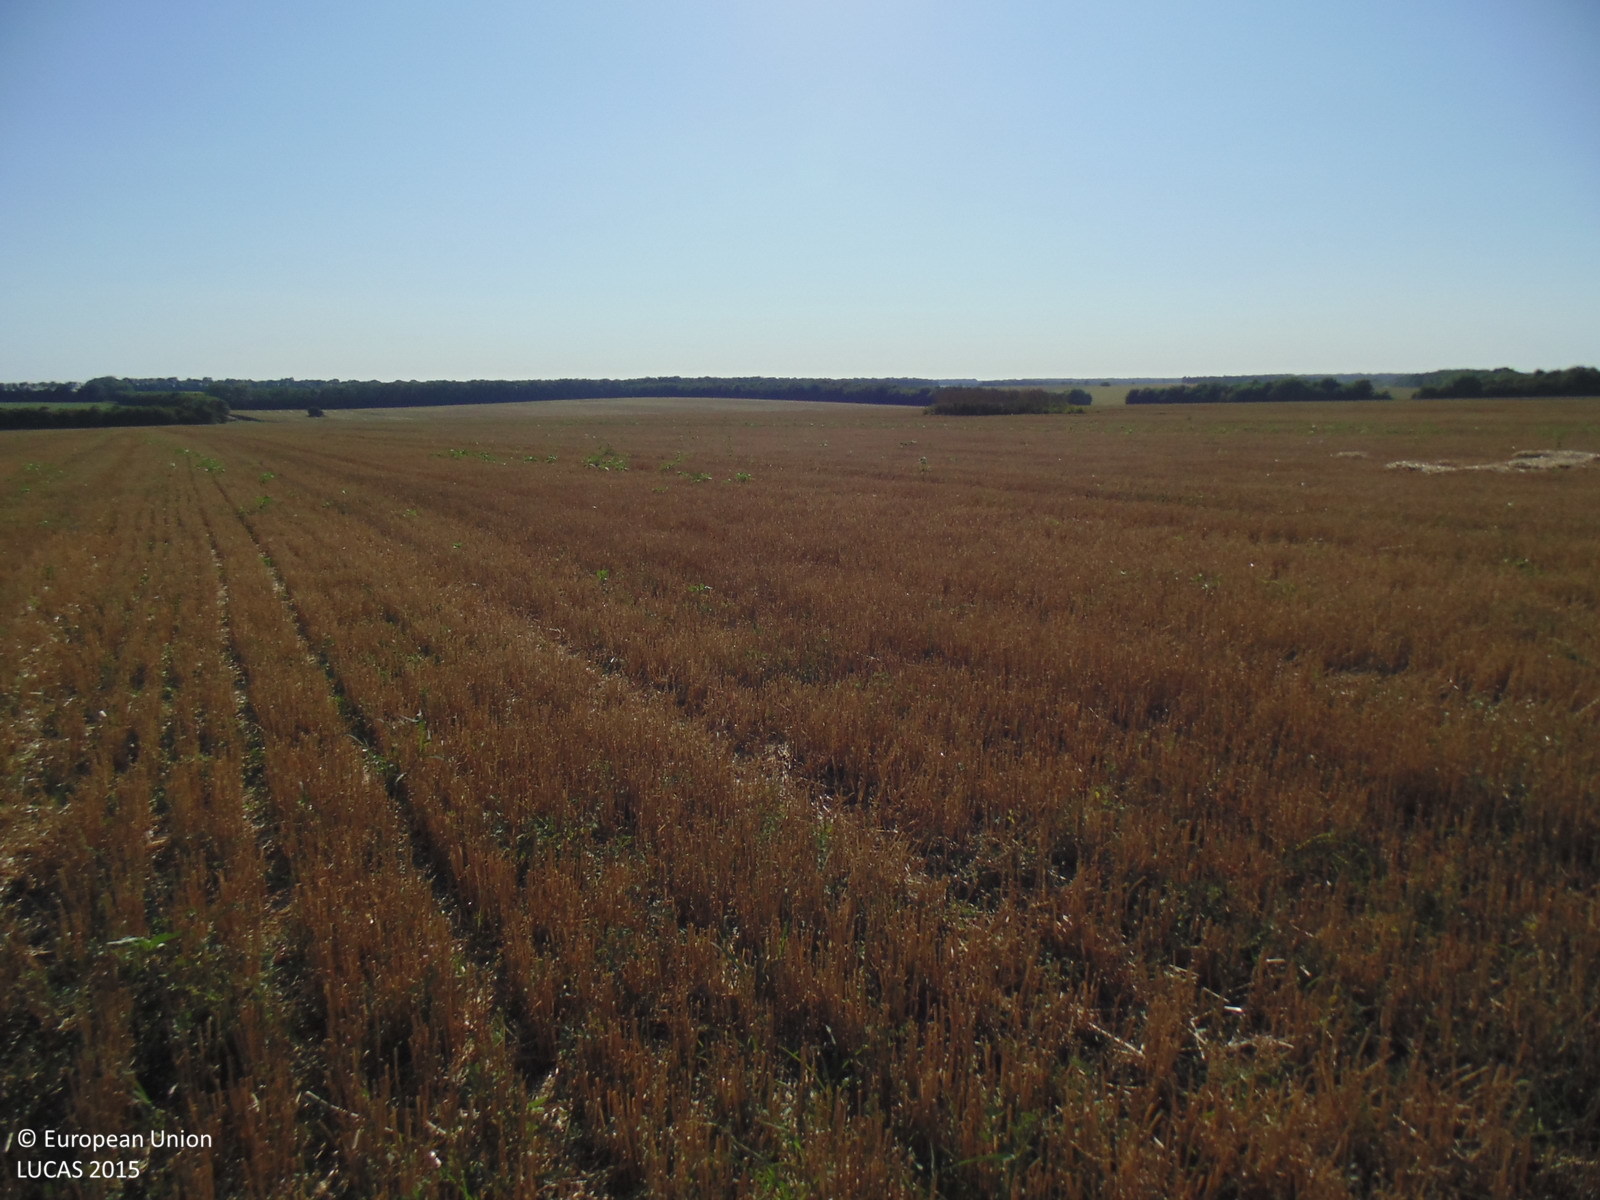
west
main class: Cropland
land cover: Common wheat
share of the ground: > 75 %
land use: Agriculture (excluding fallow land and kitchen gardens)
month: August
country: BG
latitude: 43.4740
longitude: 28.2383
